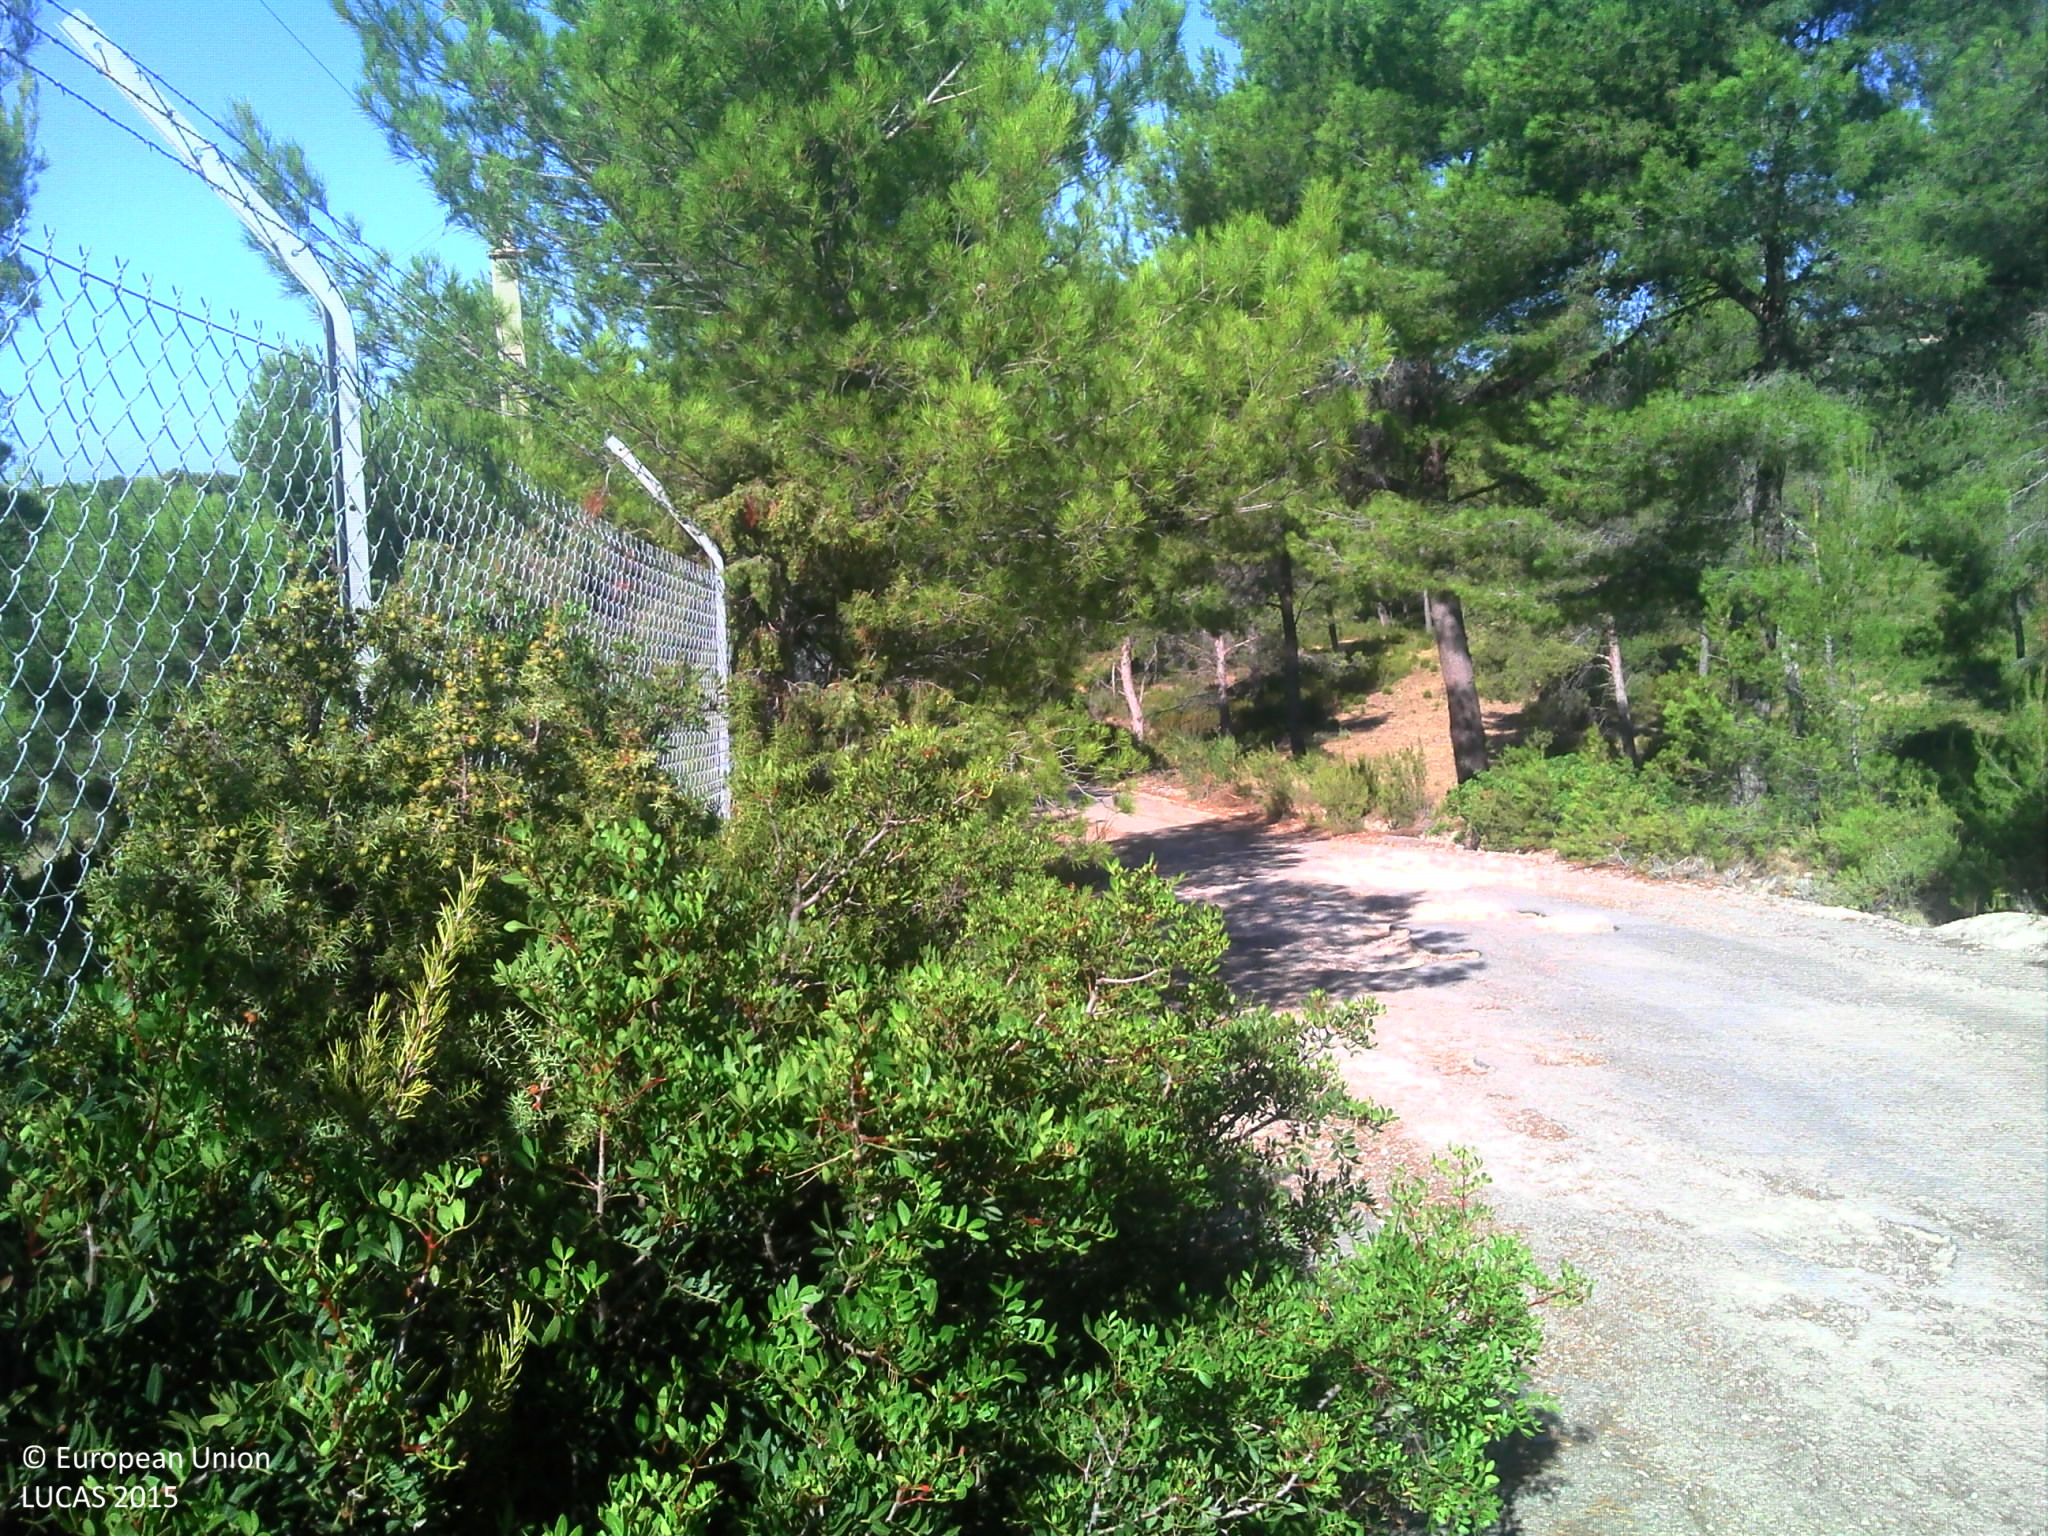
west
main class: Woodland
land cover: Pine dominated coniferous woodland
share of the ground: > 75 %
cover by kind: coniferous forest trees 35 %, herbaceous plants 30 %, consolidated bare surface 25 %, shrubs 10 %
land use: Road transport
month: August
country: FR
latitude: 43.1941
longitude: 5.6666
